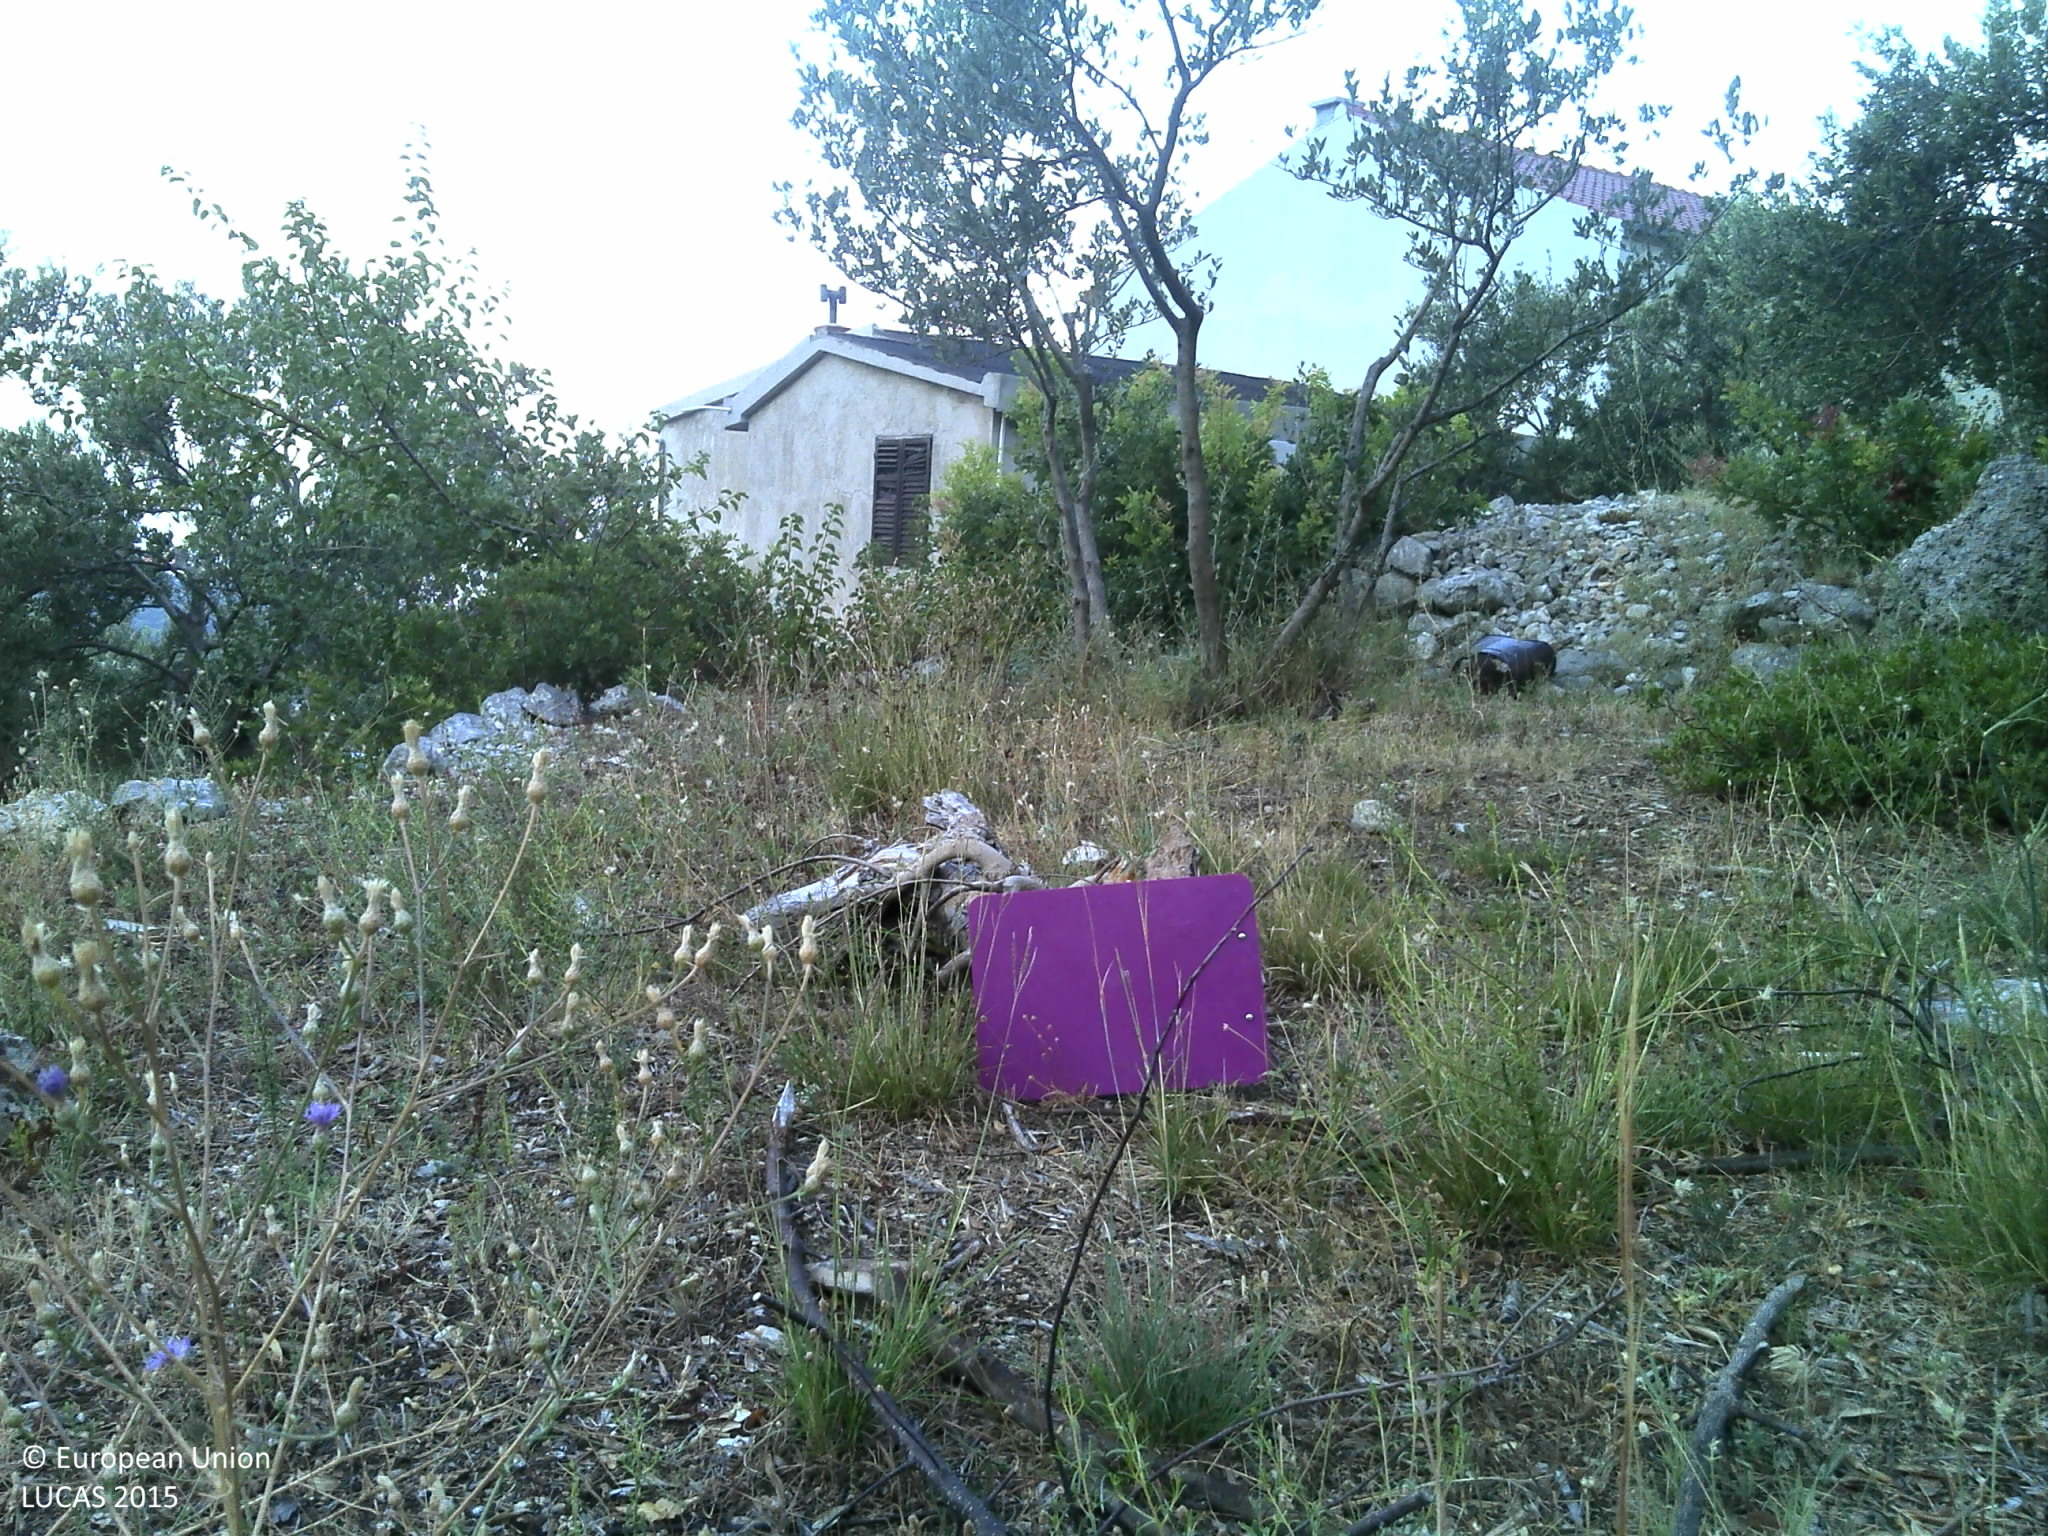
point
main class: Cropland
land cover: Olive groves
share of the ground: > 75 %
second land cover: Grassland without tree/shrub cover
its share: > 75 %
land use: Agriculture (excluding fallow land and kitchen gardens)
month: August
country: HR
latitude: 43.2973
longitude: 17.0292
